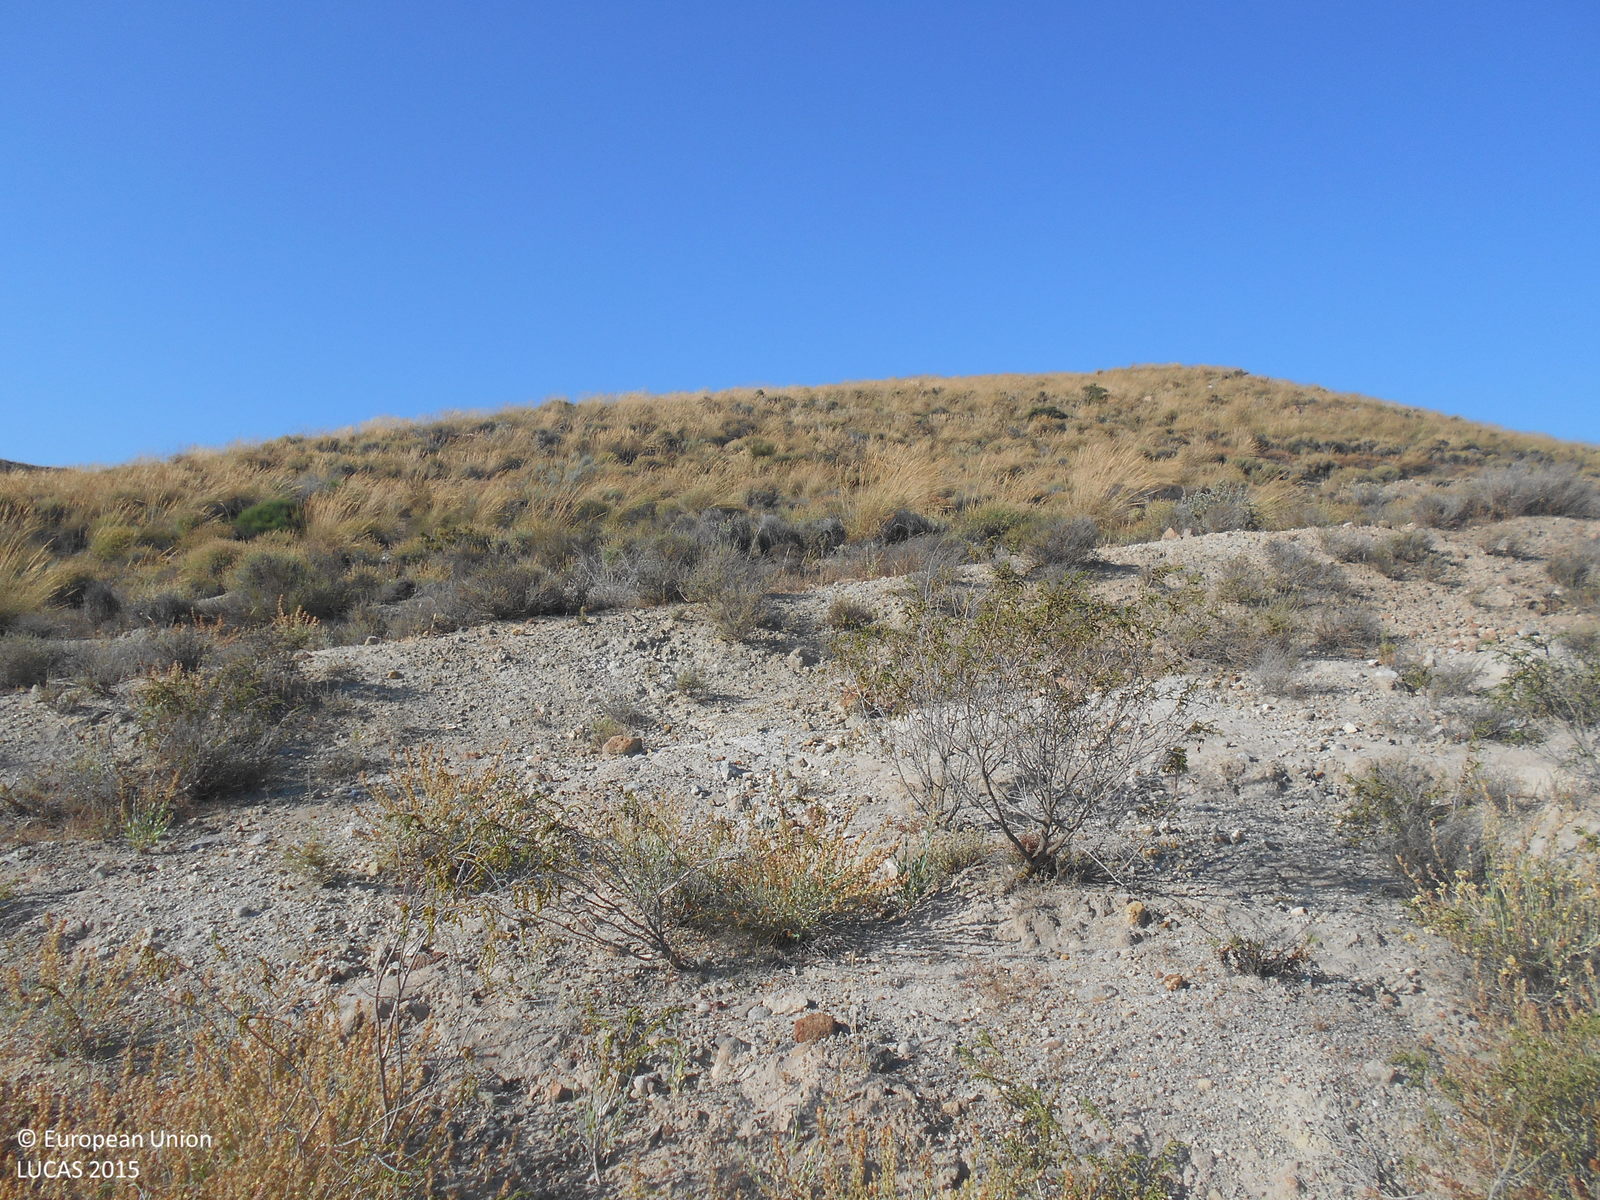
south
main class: Shrubland
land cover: Shrubland without tree cover
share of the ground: 25 - 50 %
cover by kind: unconsolidated bare surface 50 %, shrubs 40 %, herbaceous plants 10 %
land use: Semi-natural and natural areas not in use
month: May
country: ES
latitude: 36.8950
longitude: -2.1270
